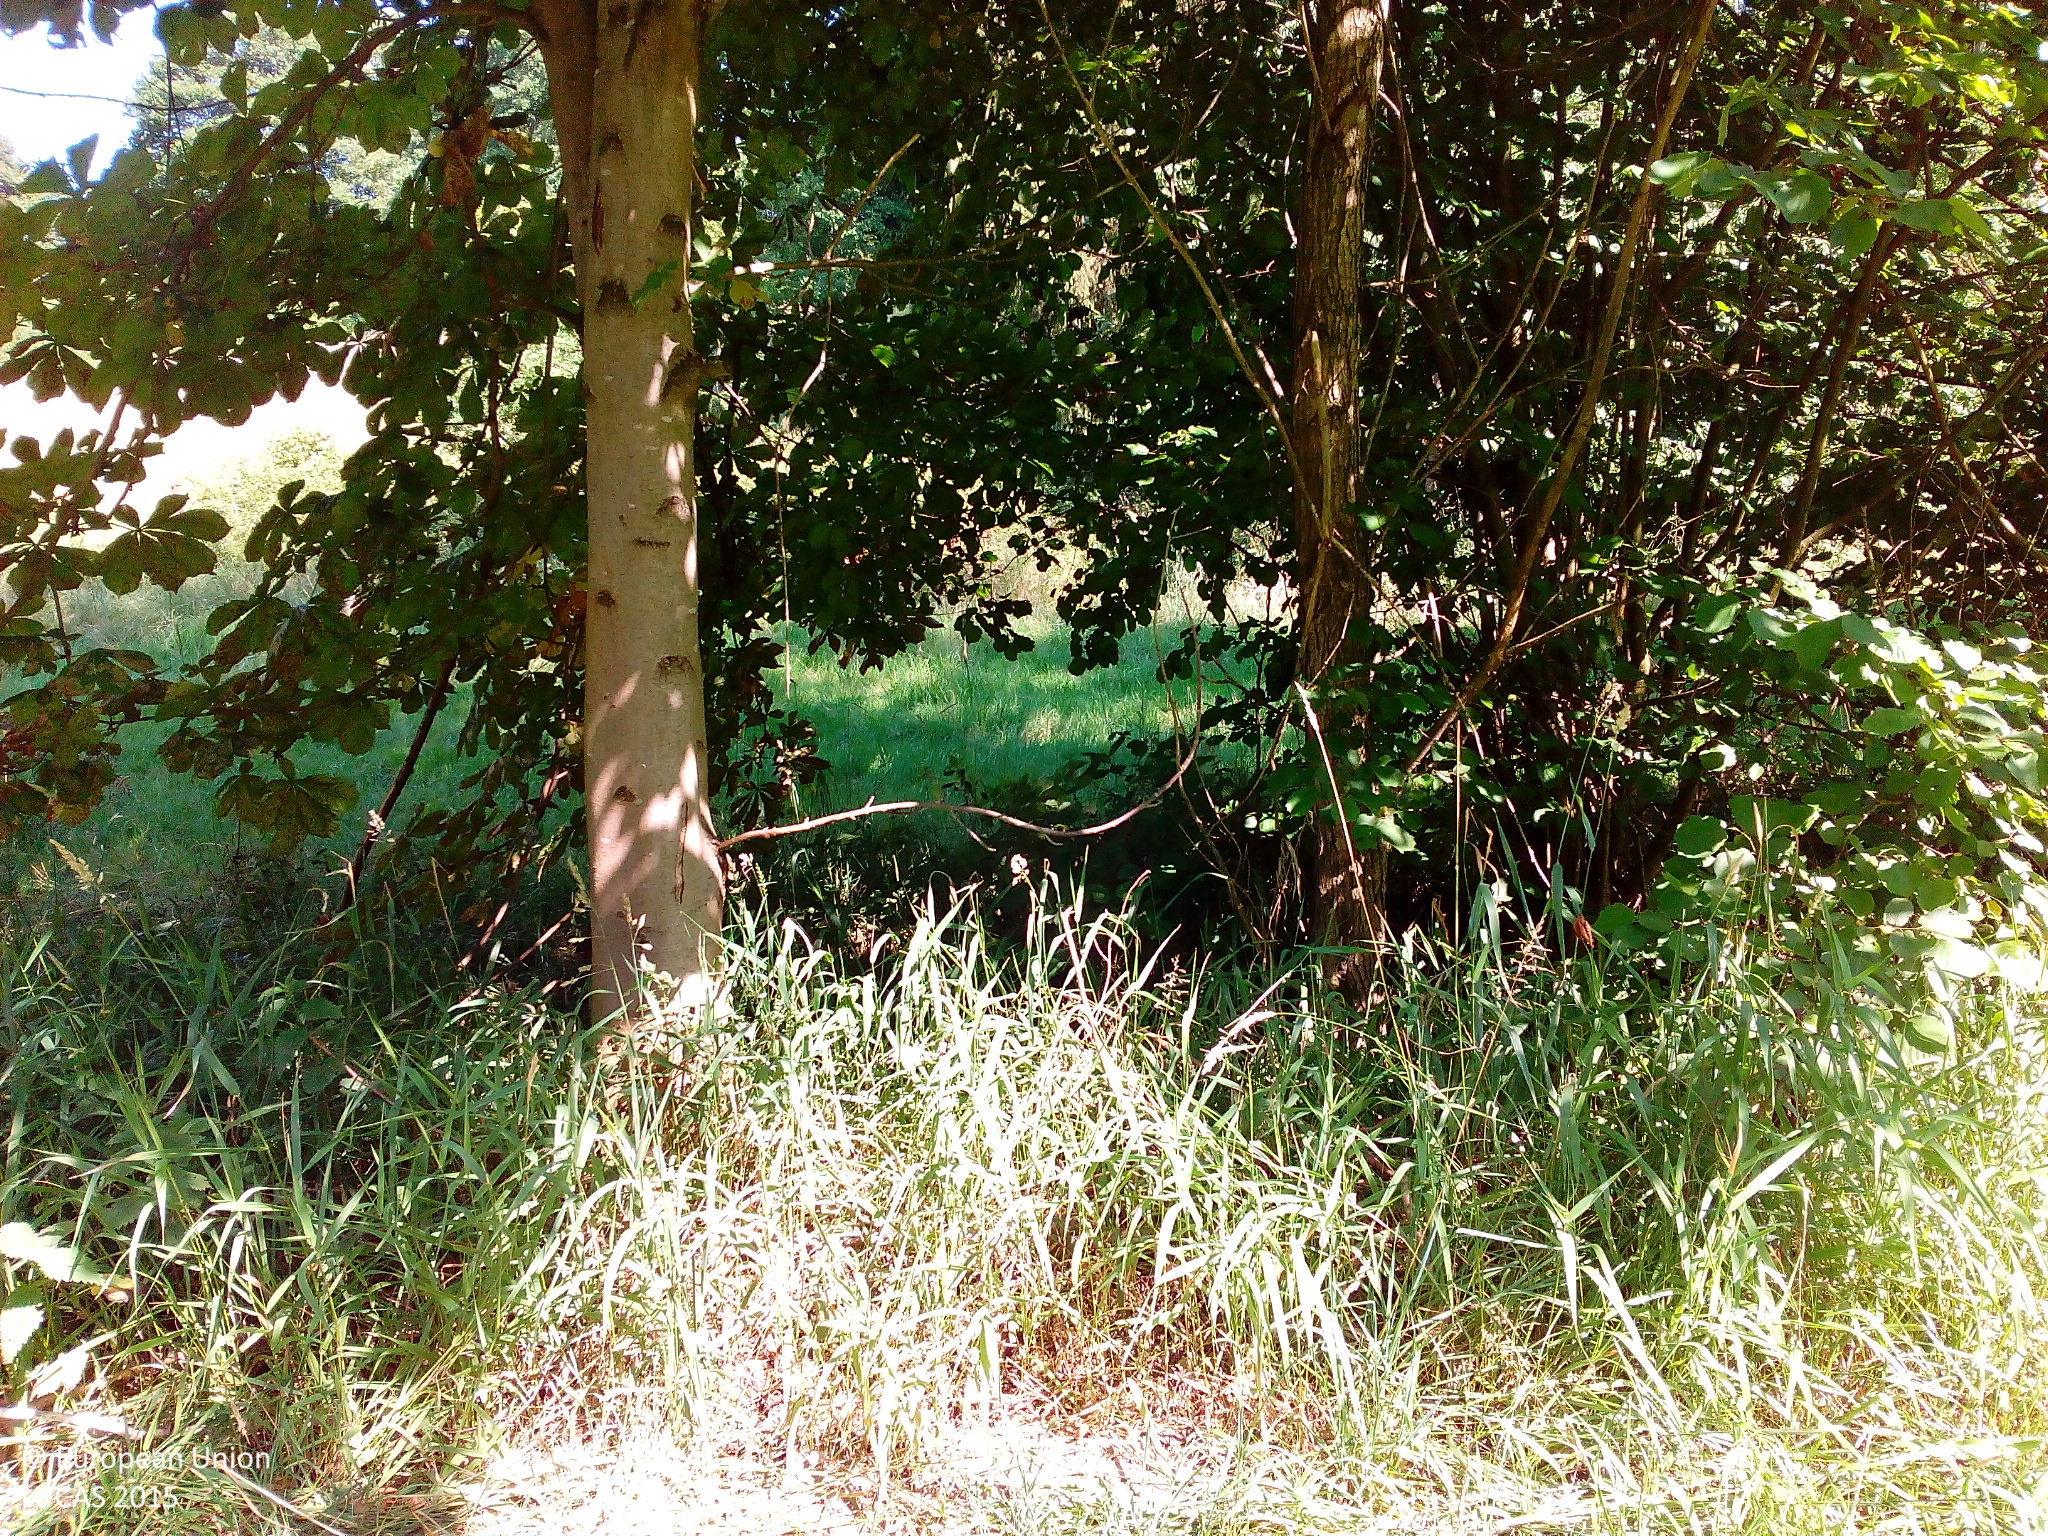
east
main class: Grassland
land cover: Grassland without tree/shrub cover
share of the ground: > 75 %
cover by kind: herbaceous plants 100 %
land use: Agriculture (excluding fallow land and kitchen gardens)
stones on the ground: < 10 %
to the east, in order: Grassland without tree/shrub cover; Lines of trees; Ditches and canals; Lines of trees; Grassland without tree/shrub cover; Spruce dominated mixed woodland; Grassland without tree/shrub cover; Spruce dominated mixed woodland; Fences; Shrubland with sparse tree cover; Fences; Broadleaved woodland; Spontaneously vegetated surfaces
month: July
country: DE
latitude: 50.9393
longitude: 9.8720
